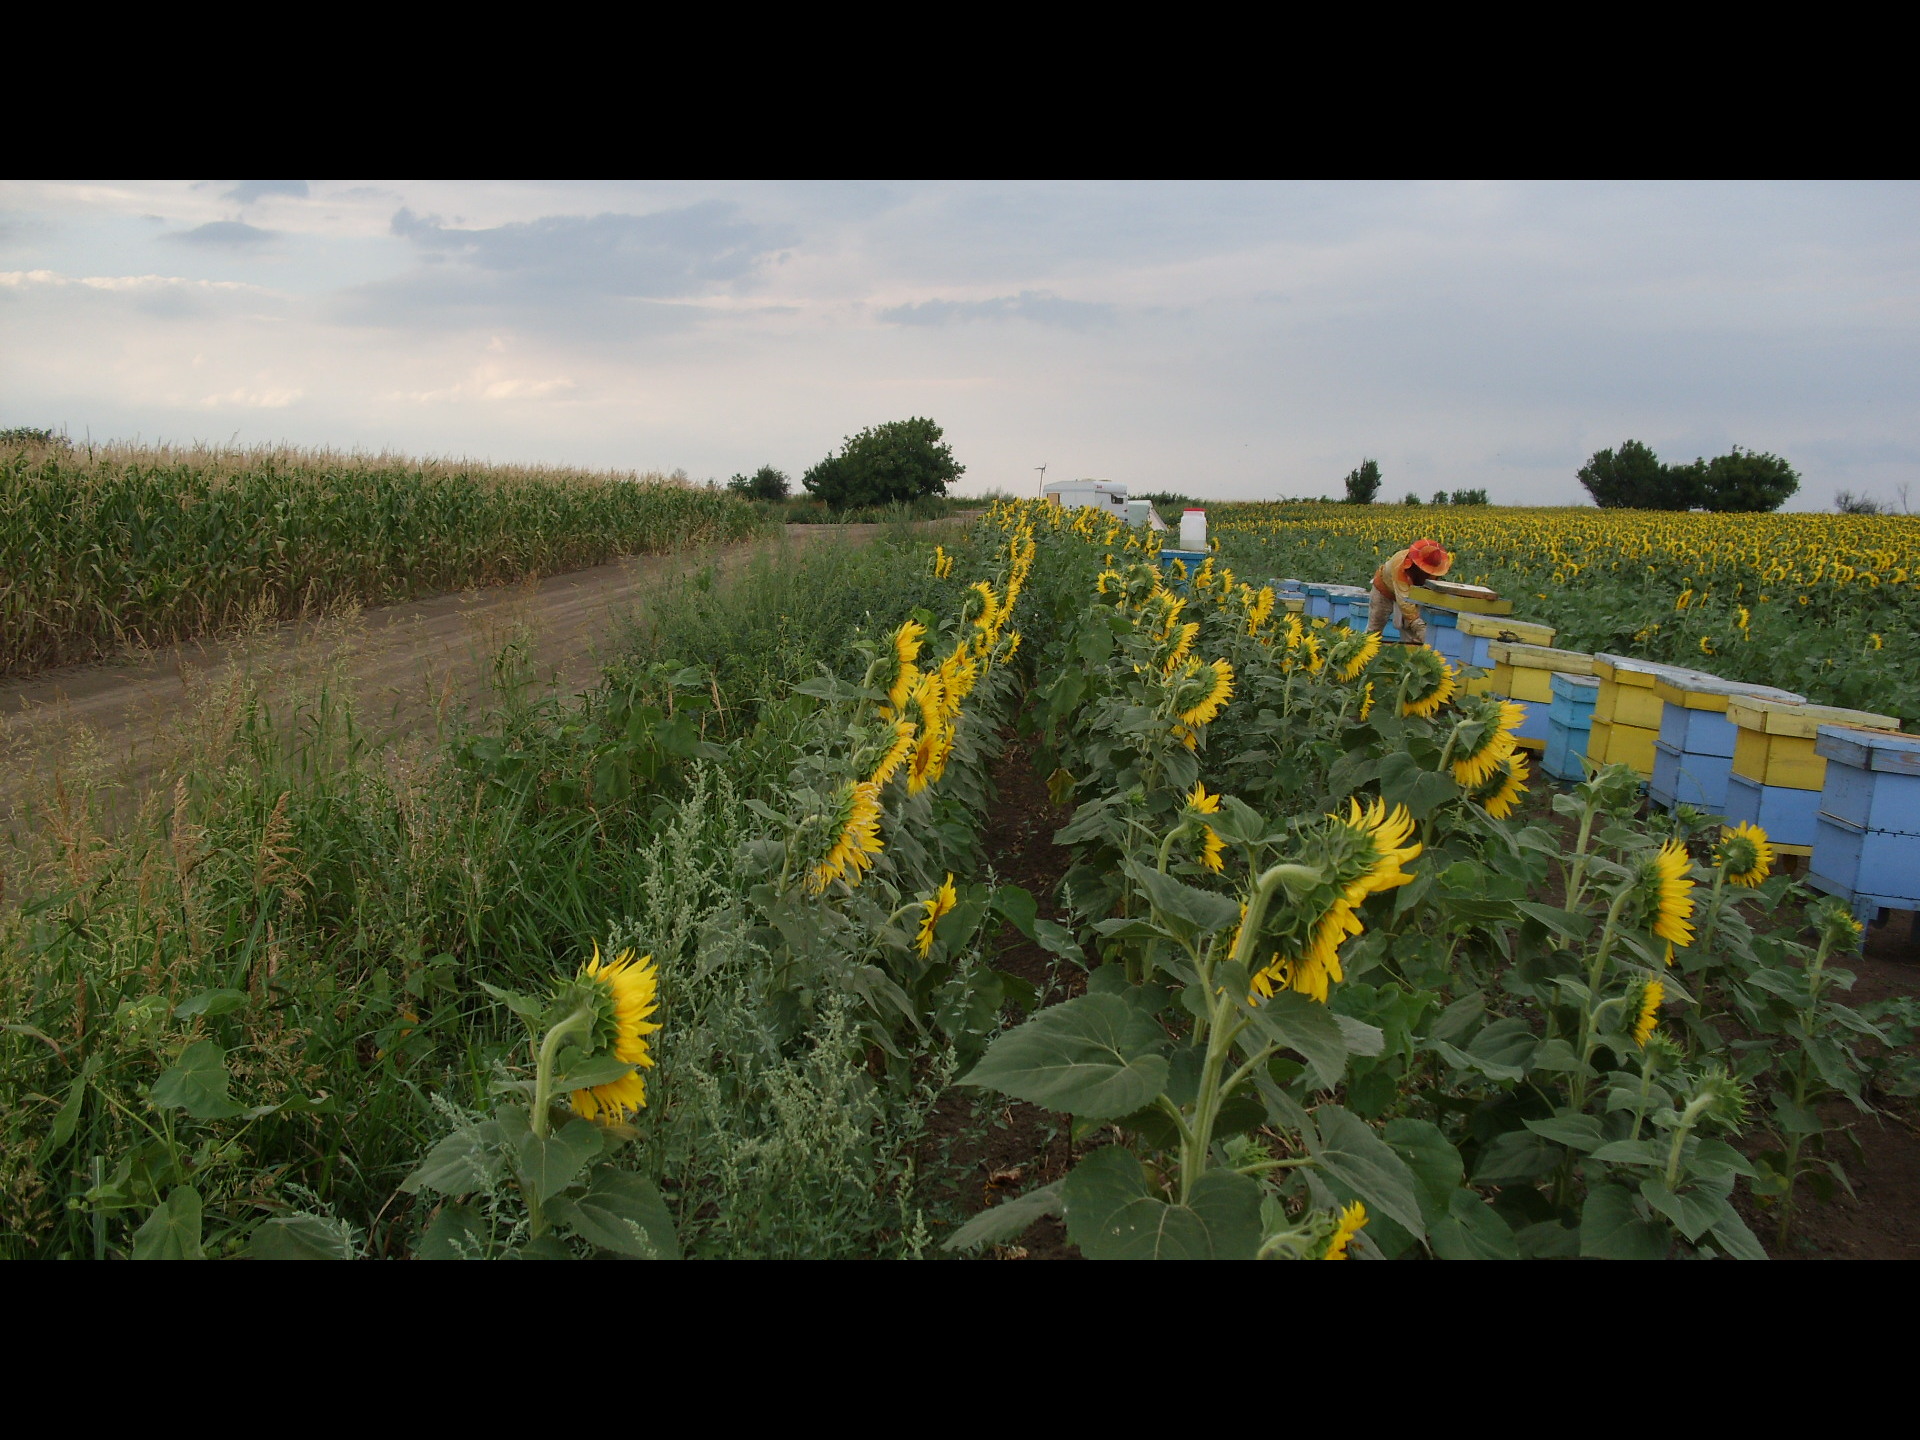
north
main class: Cropland
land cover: Sunflower
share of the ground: > 75 %
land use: Agriculture (excluding fallow land and kitchen gardens)
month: July
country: BG
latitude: 43.7820
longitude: 23.5798
